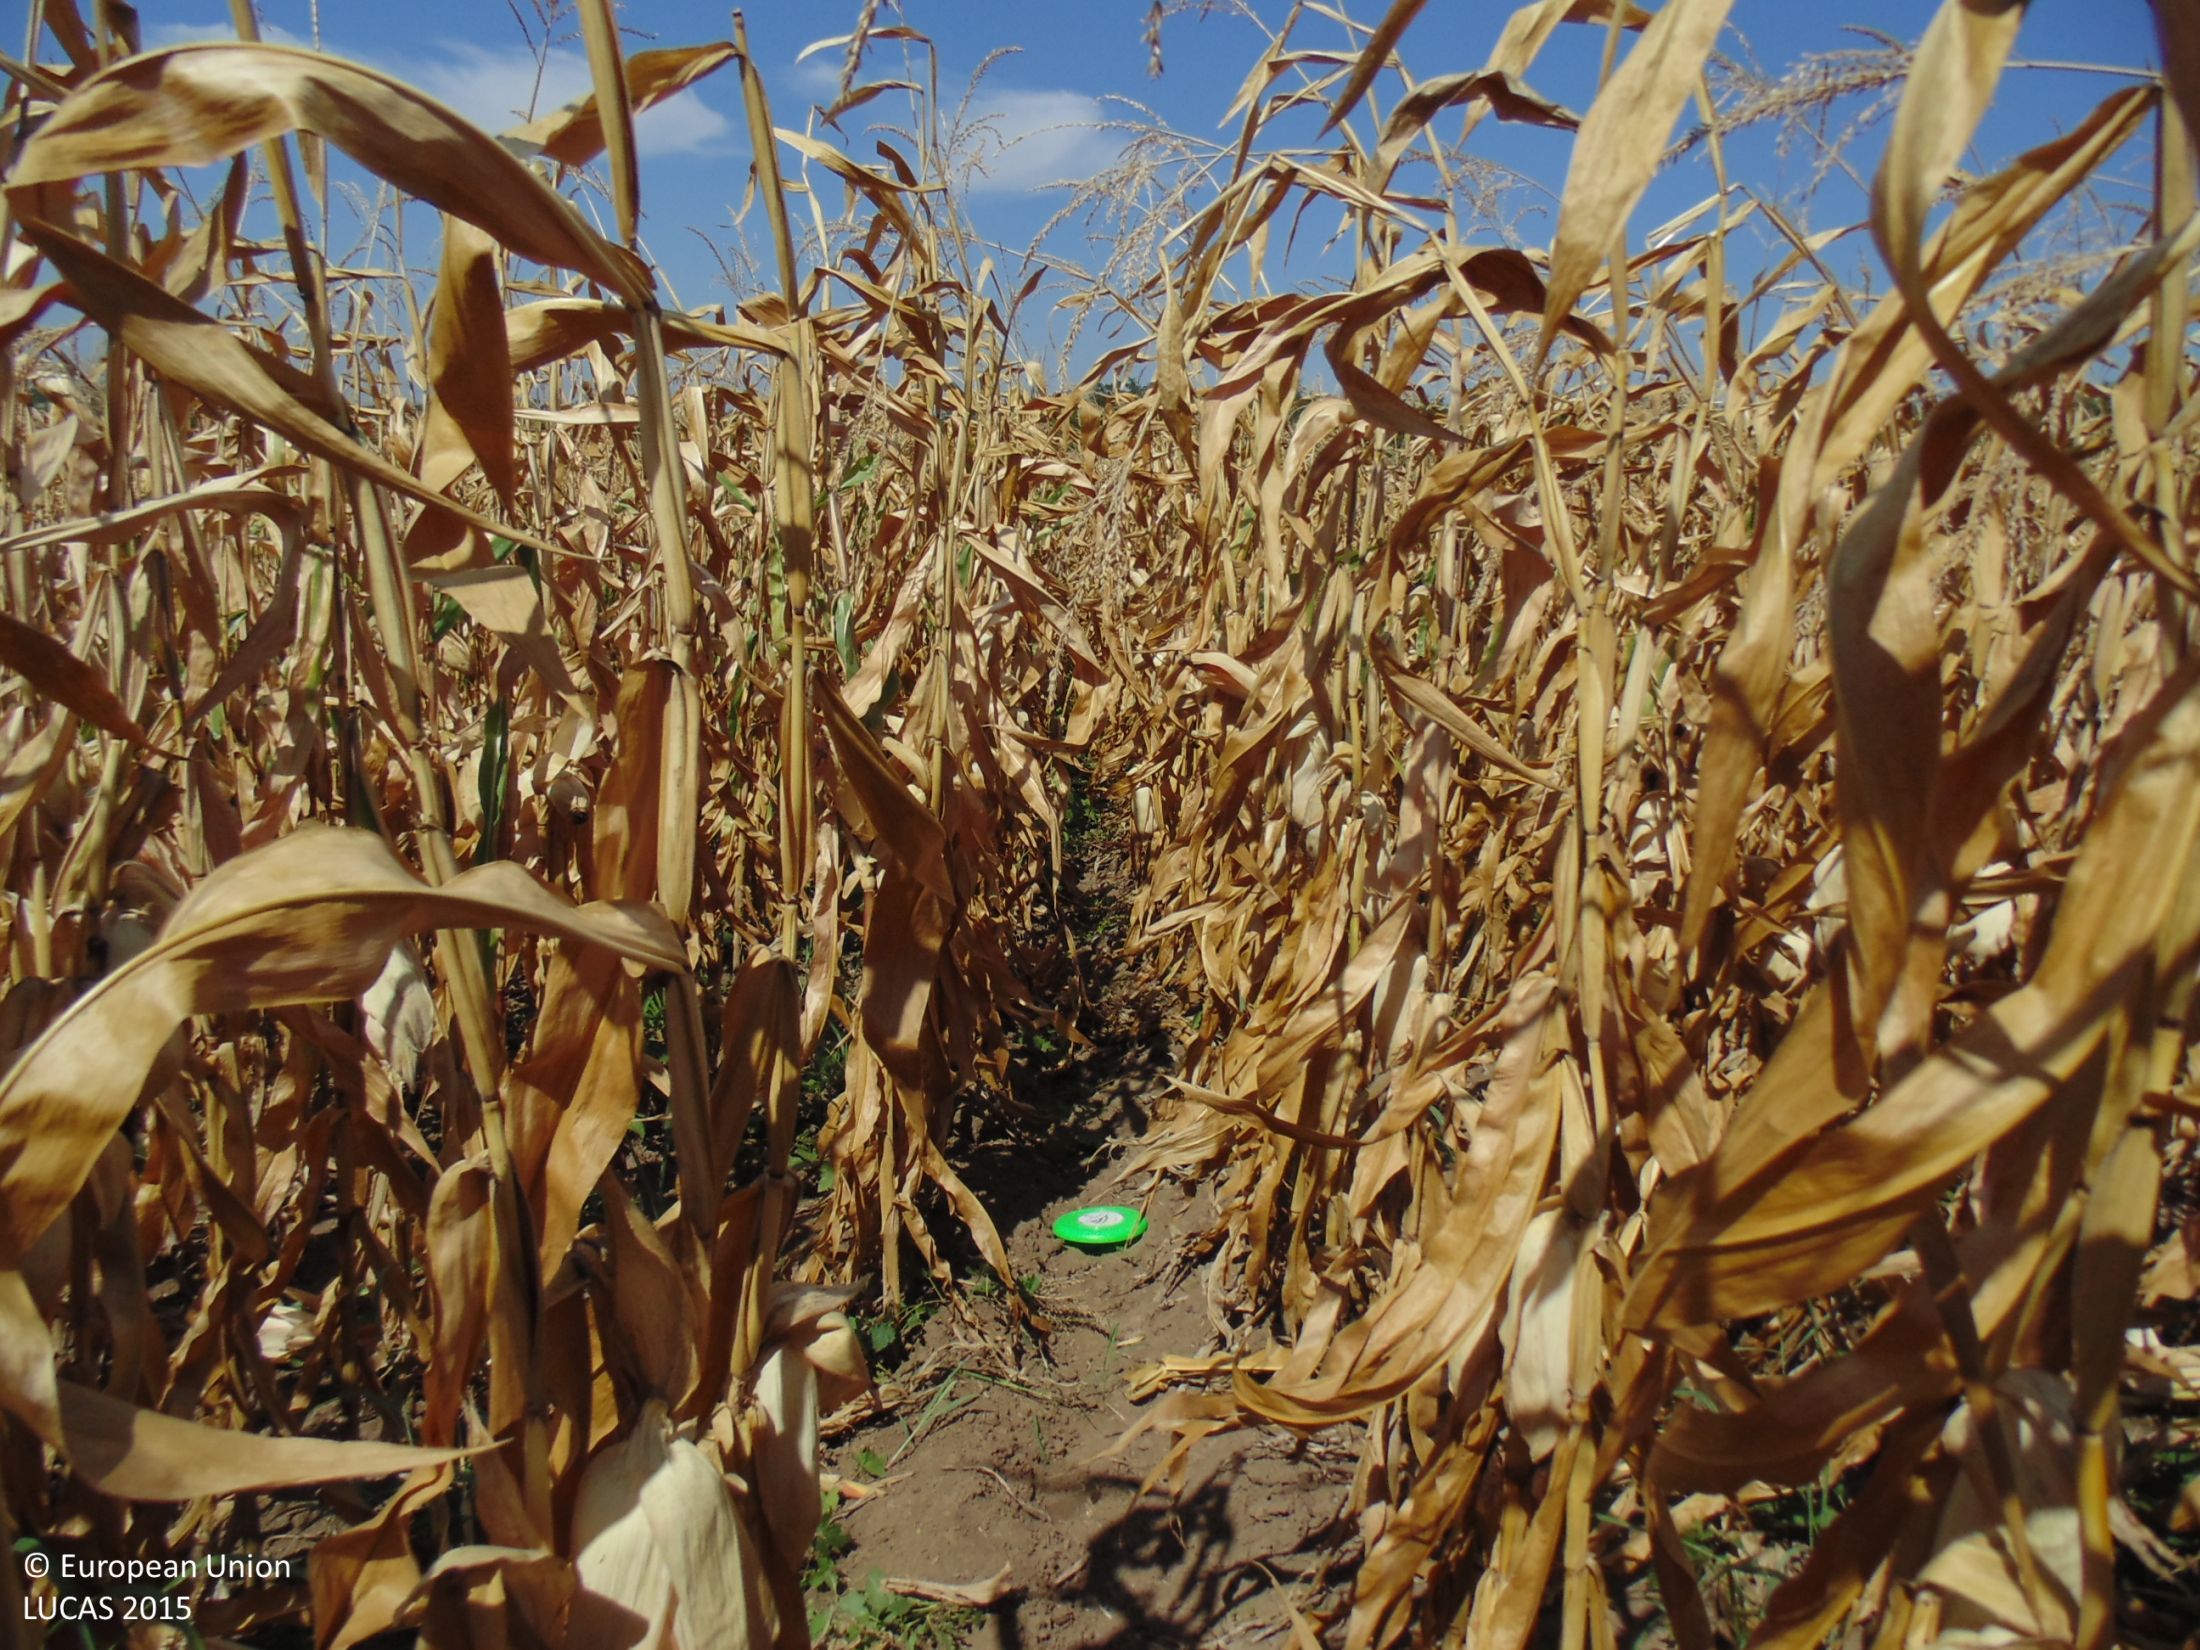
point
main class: Cropland
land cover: Maize
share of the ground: > 75 %
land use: Agriculture (excluding fallow land and kitchen gardens)
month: September
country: BG
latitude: 43.9125
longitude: 27.0978
